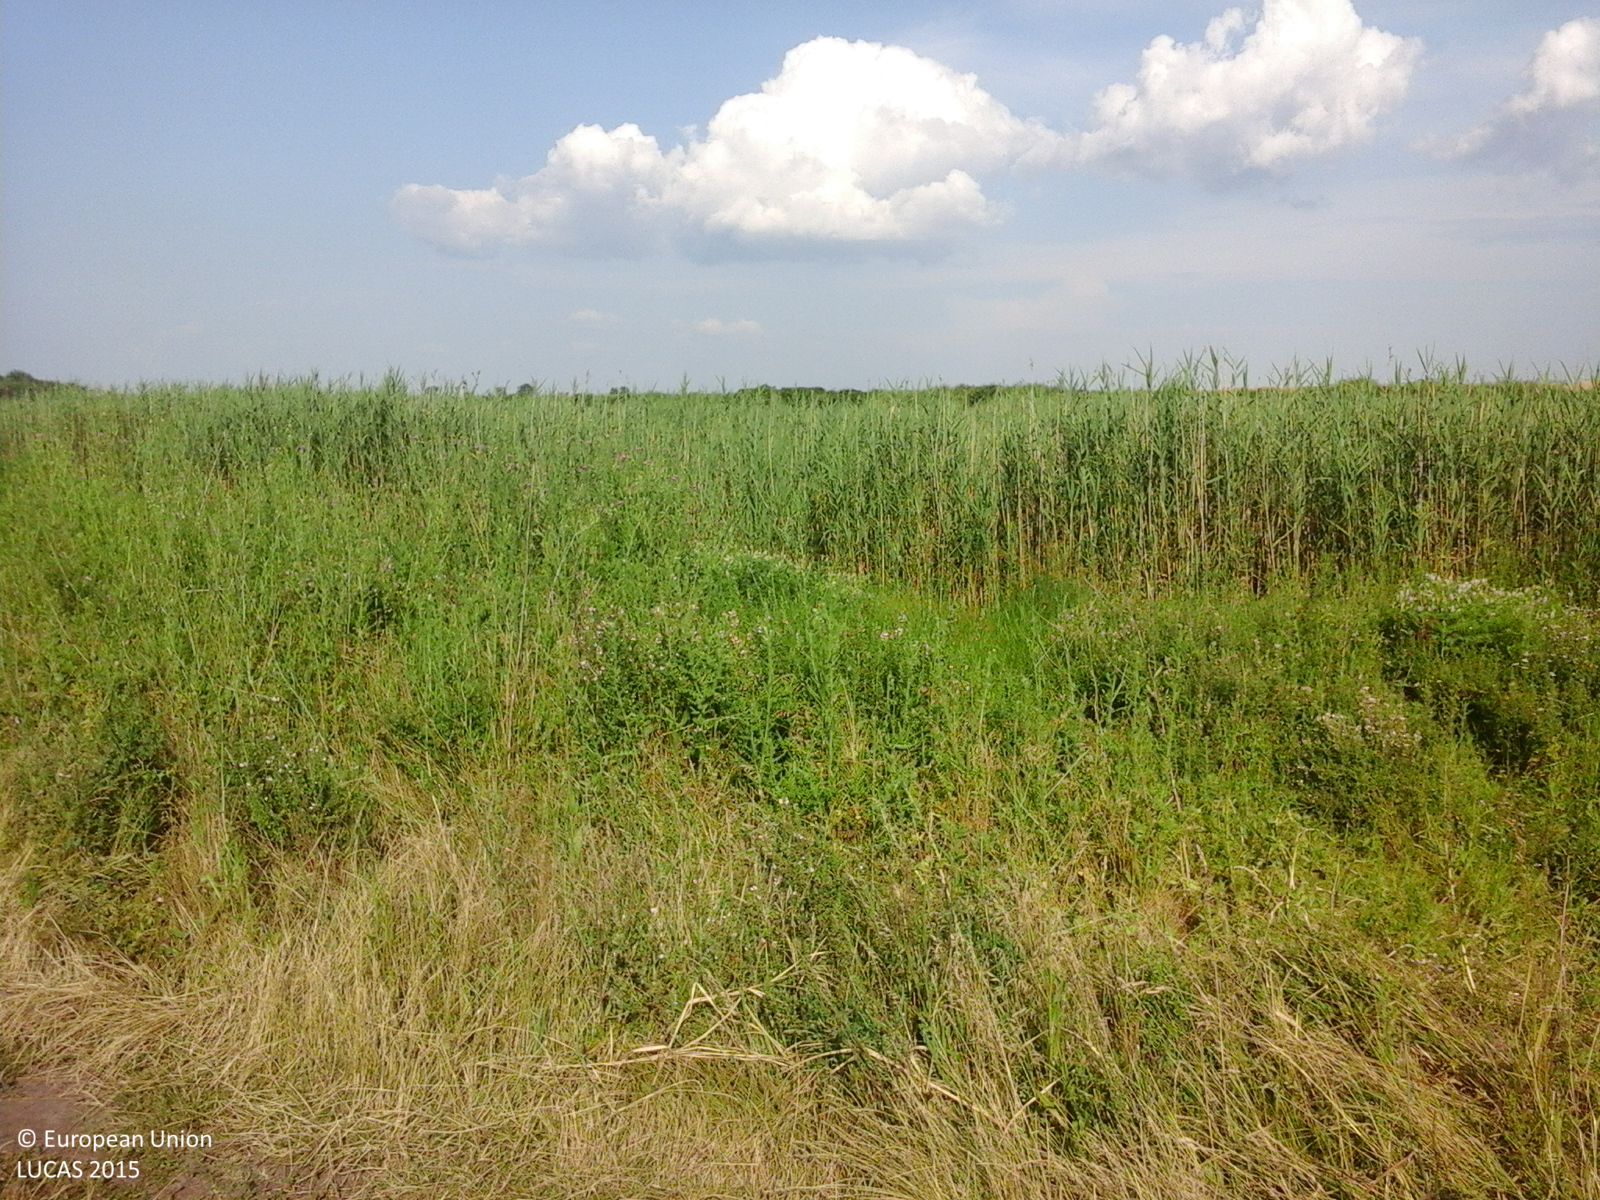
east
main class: Cropland
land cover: Common wheat
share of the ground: > 75 %
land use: Agriculture (excluding fallow land and kitchen gardens)
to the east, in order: Common wheat; Dry pulses
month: July
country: RO
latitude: 43.8425
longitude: 25.8266
